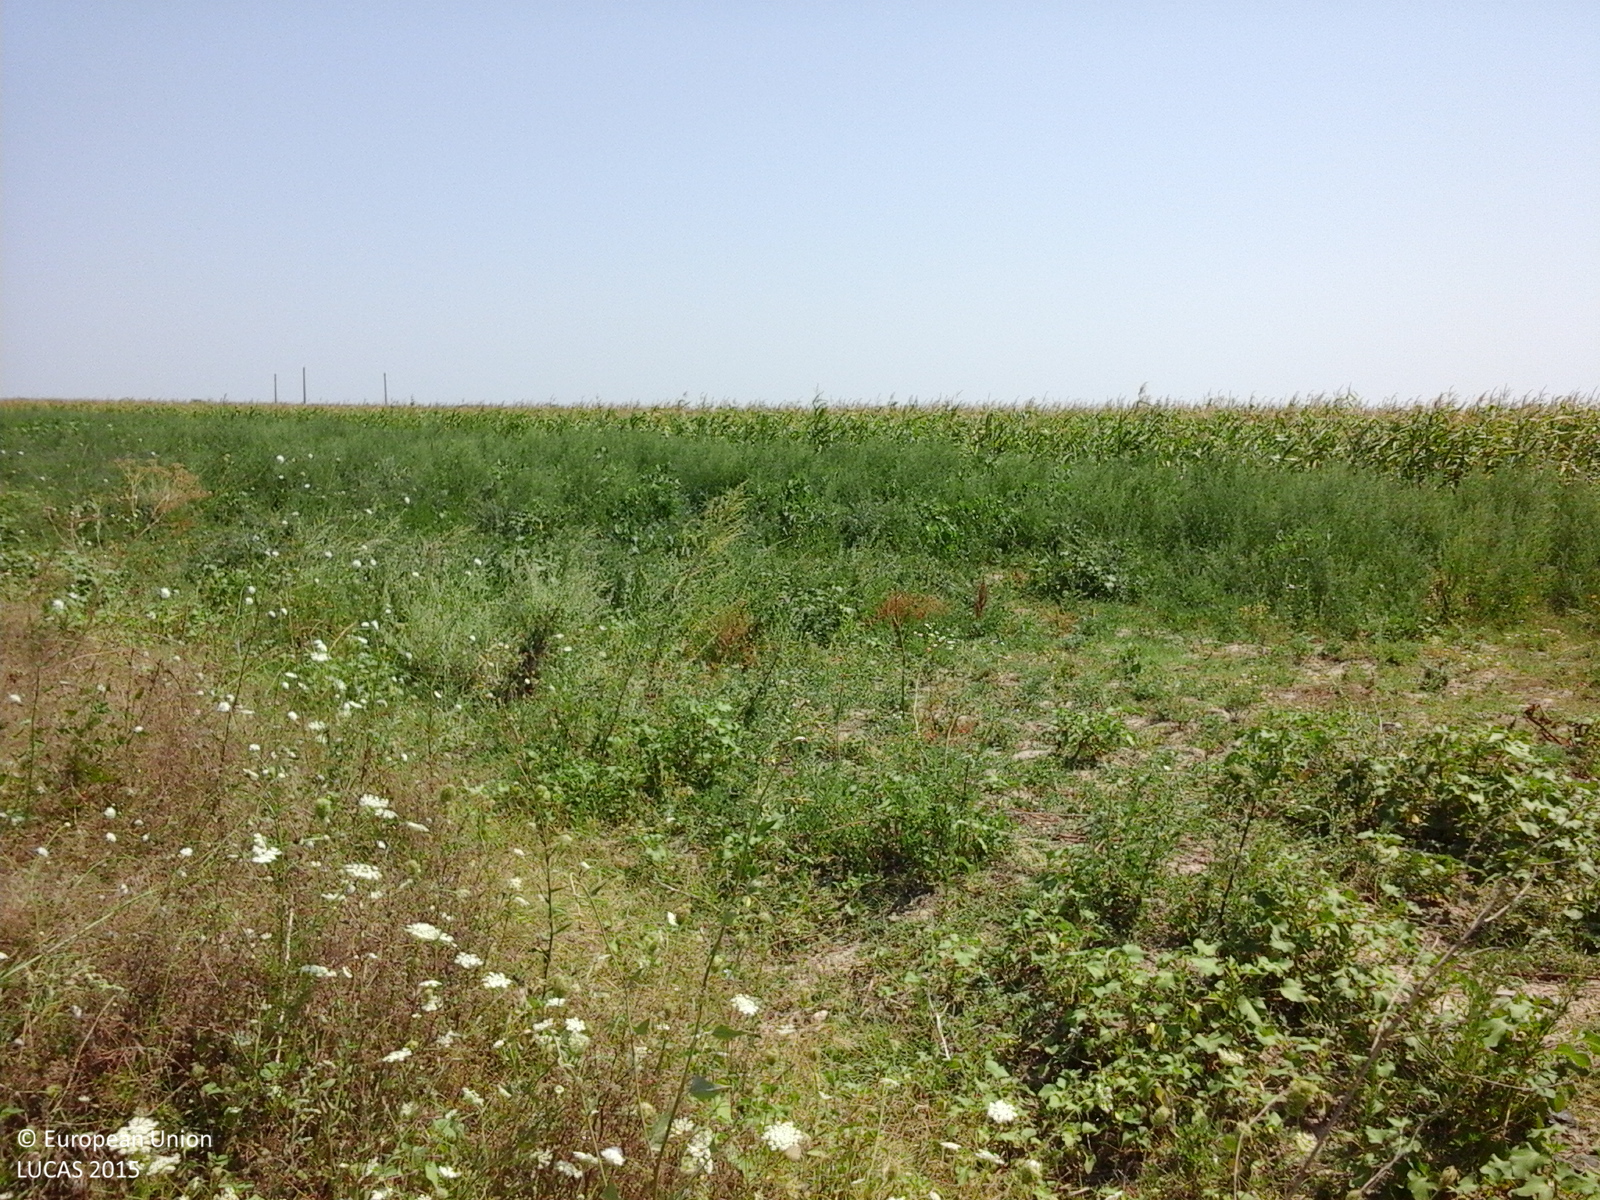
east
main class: Grassland
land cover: Spontaneously vegetated surfaces
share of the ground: > 75 %
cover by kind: herbaceous plants 100 %
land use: Fallow land
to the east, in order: Spontaneously vegetated surfaces; Maize
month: August
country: RO
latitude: 45.5289
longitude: 27.5564
